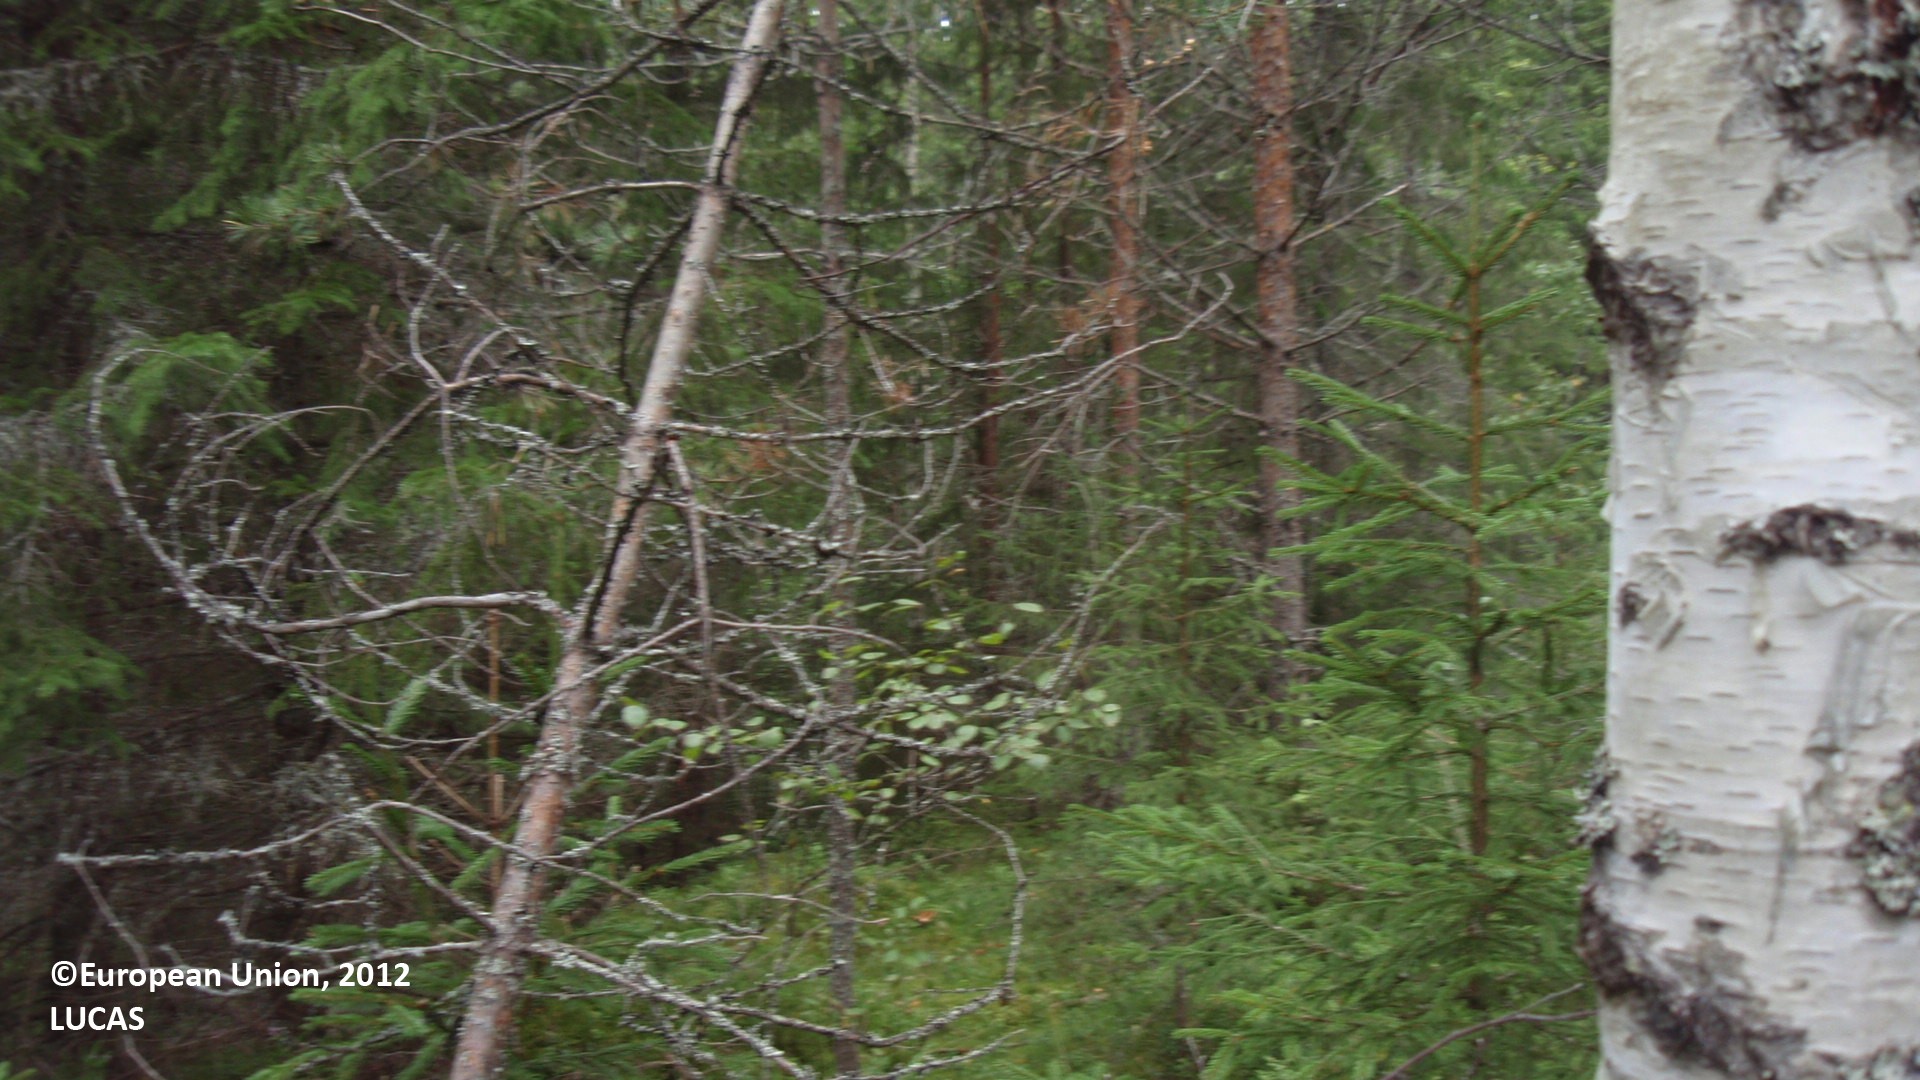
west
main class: Woodland
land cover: Other coniferous woodland
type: boreal forest
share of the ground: 50 - 75 %
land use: Forestry
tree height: > 5 m
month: August
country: FI
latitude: 61.1237
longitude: 27.6924
